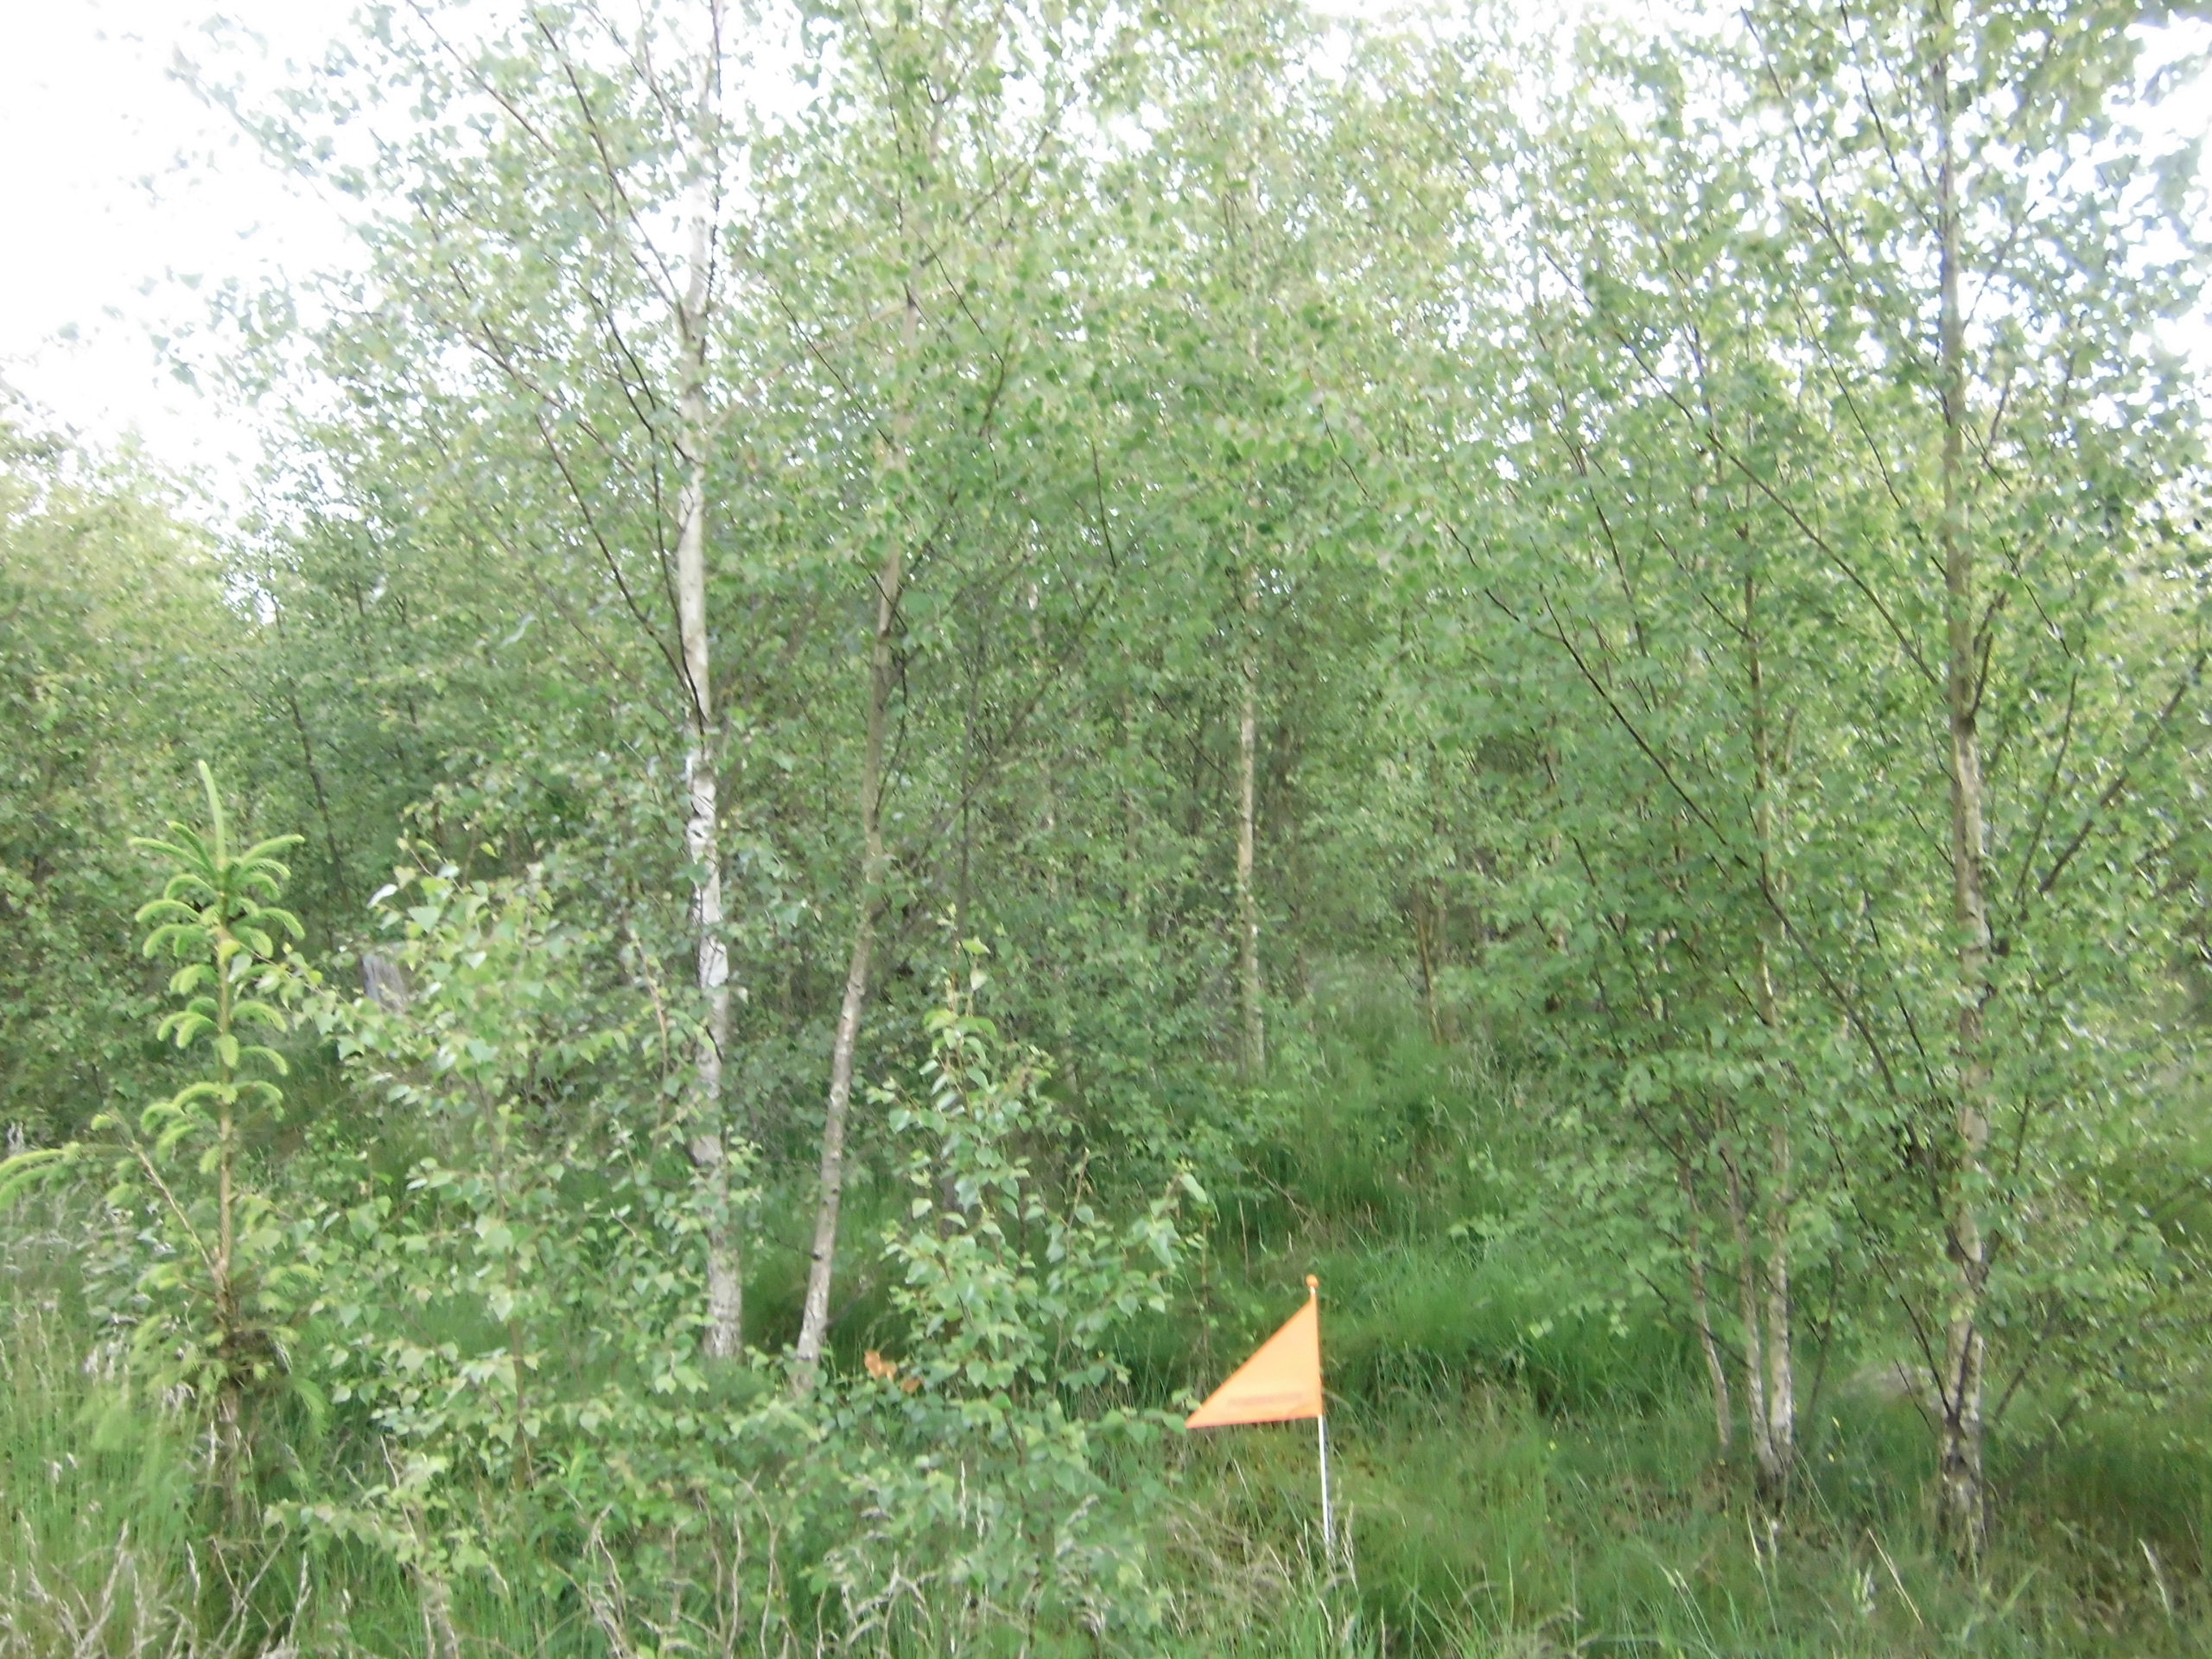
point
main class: Woodland
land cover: Broadleaved woodland
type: boreal forest
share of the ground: 50 - 75 %
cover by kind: broadleaved forest trees 60 %, herbaceous plants 15 %, coniferous forest trees 10 %, shrubs 10 %, lichens and mosses 5 %
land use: Forestry
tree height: < 5 m
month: June
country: SE
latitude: 57.0768
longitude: 14.6321
